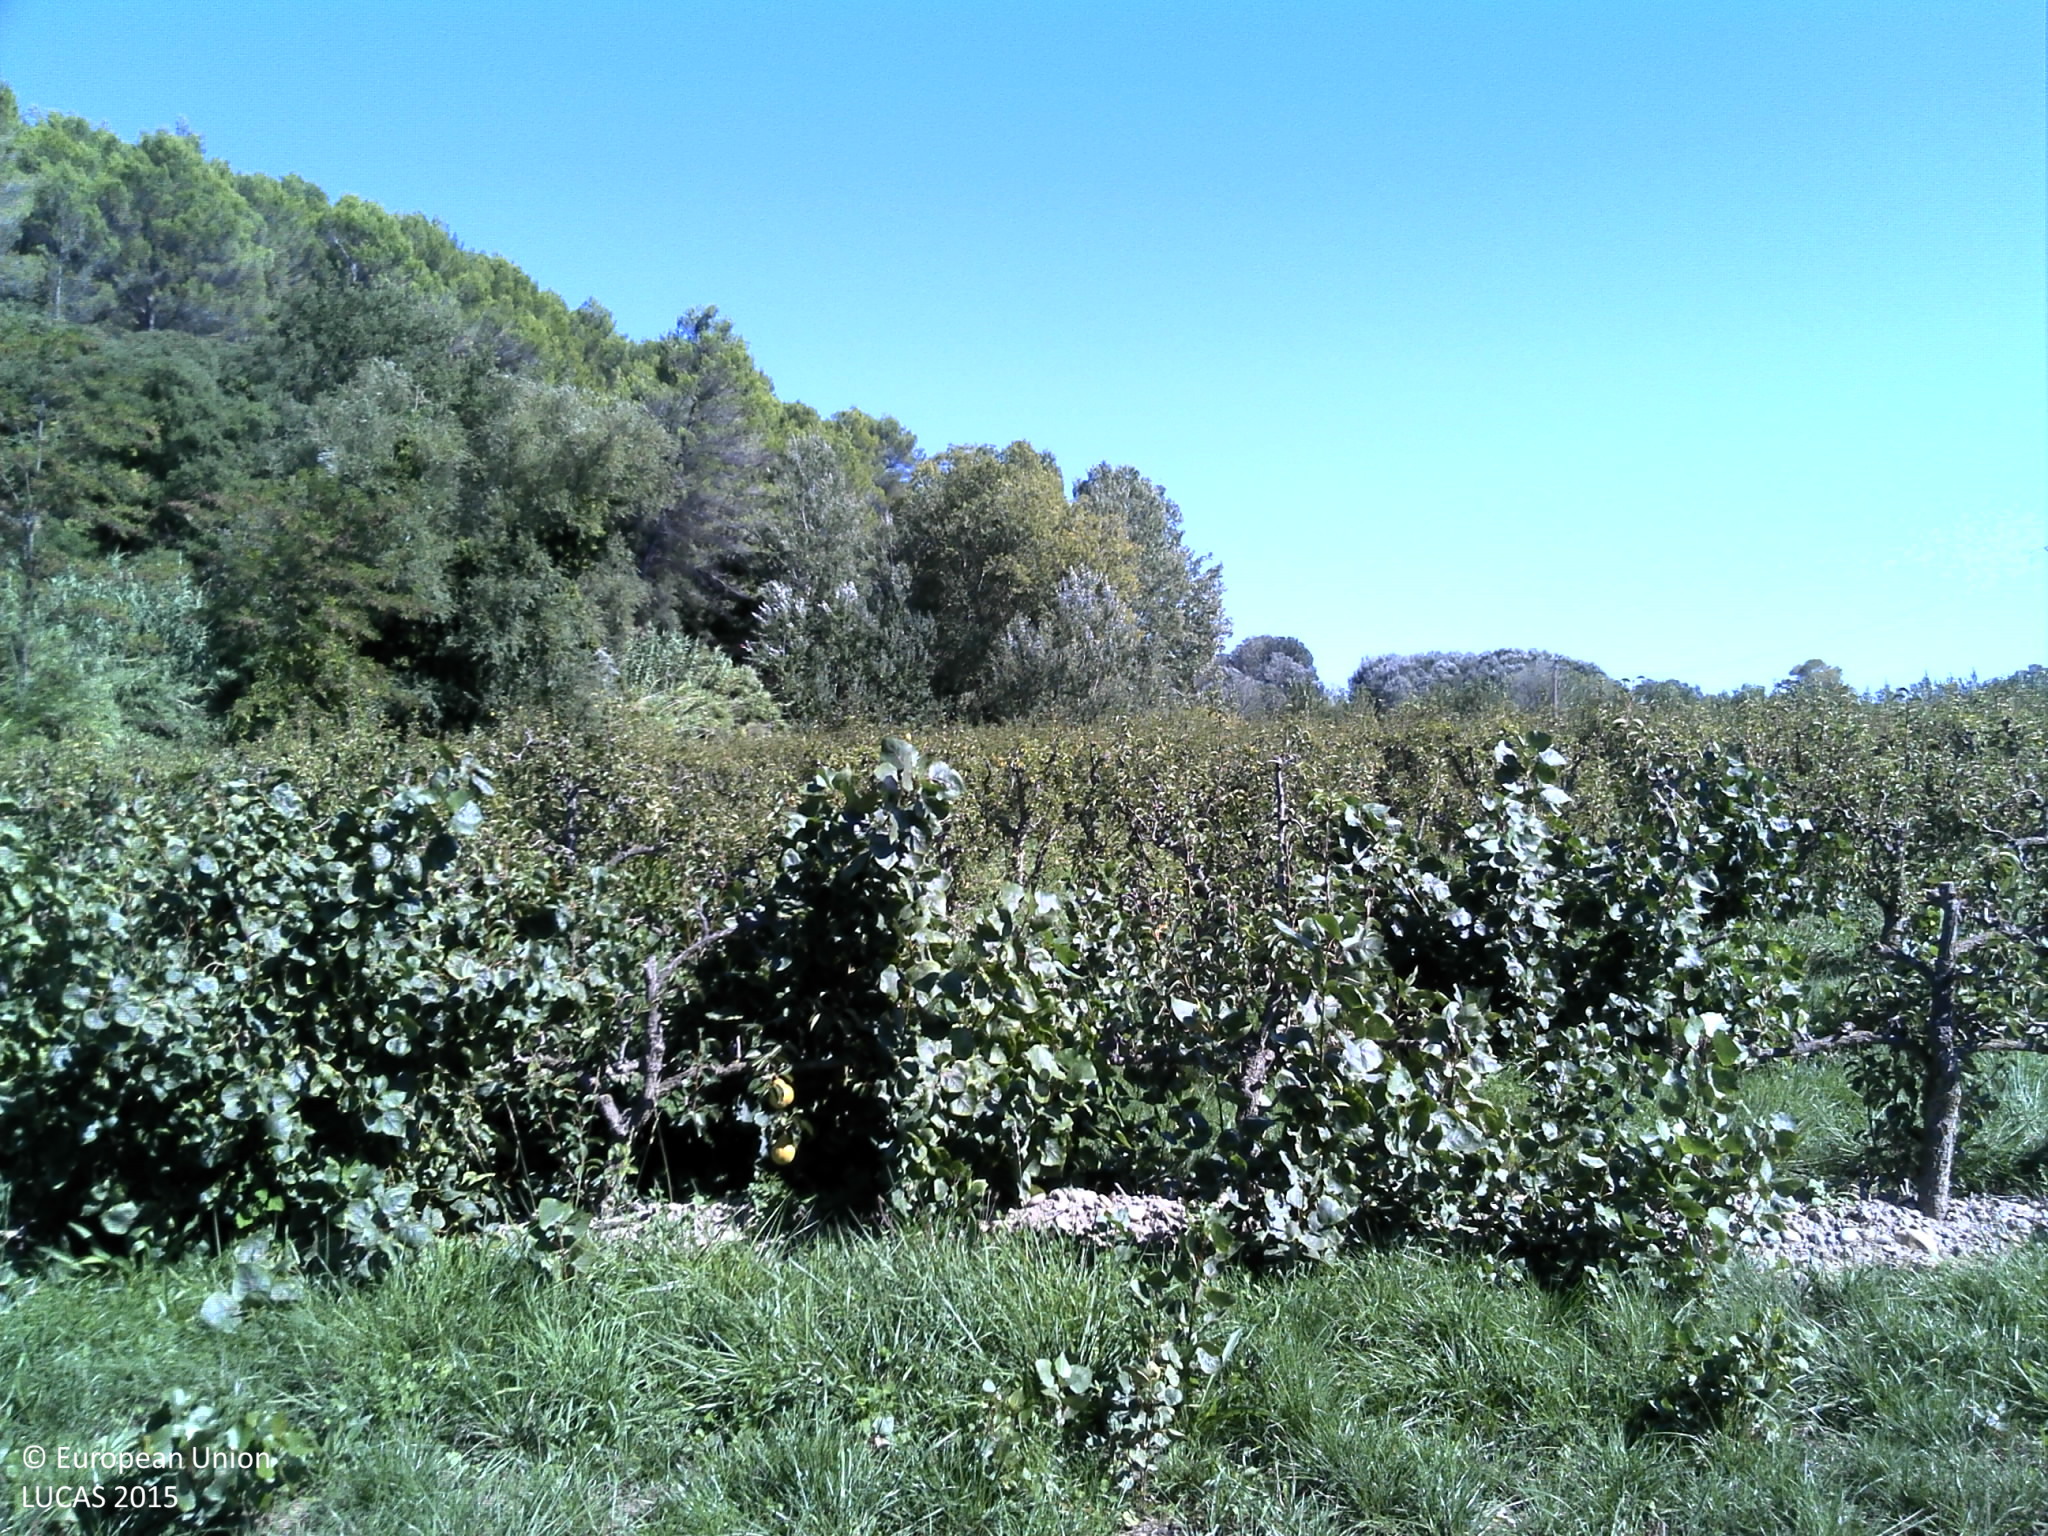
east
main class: Cropland
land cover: Pear fruit
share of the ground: 10 - 25 %
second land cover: Grassland without tree/shrub cover
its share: > 75 %
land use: Agriculture (excluding fallow land and kitchen gardens)
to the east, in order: Abandoned hedges; Pear fruit; Grassland without tree/shrub cover; Pine dominated mixed woodland
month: September
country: FR
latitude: 43.7541
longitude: 5.2524
